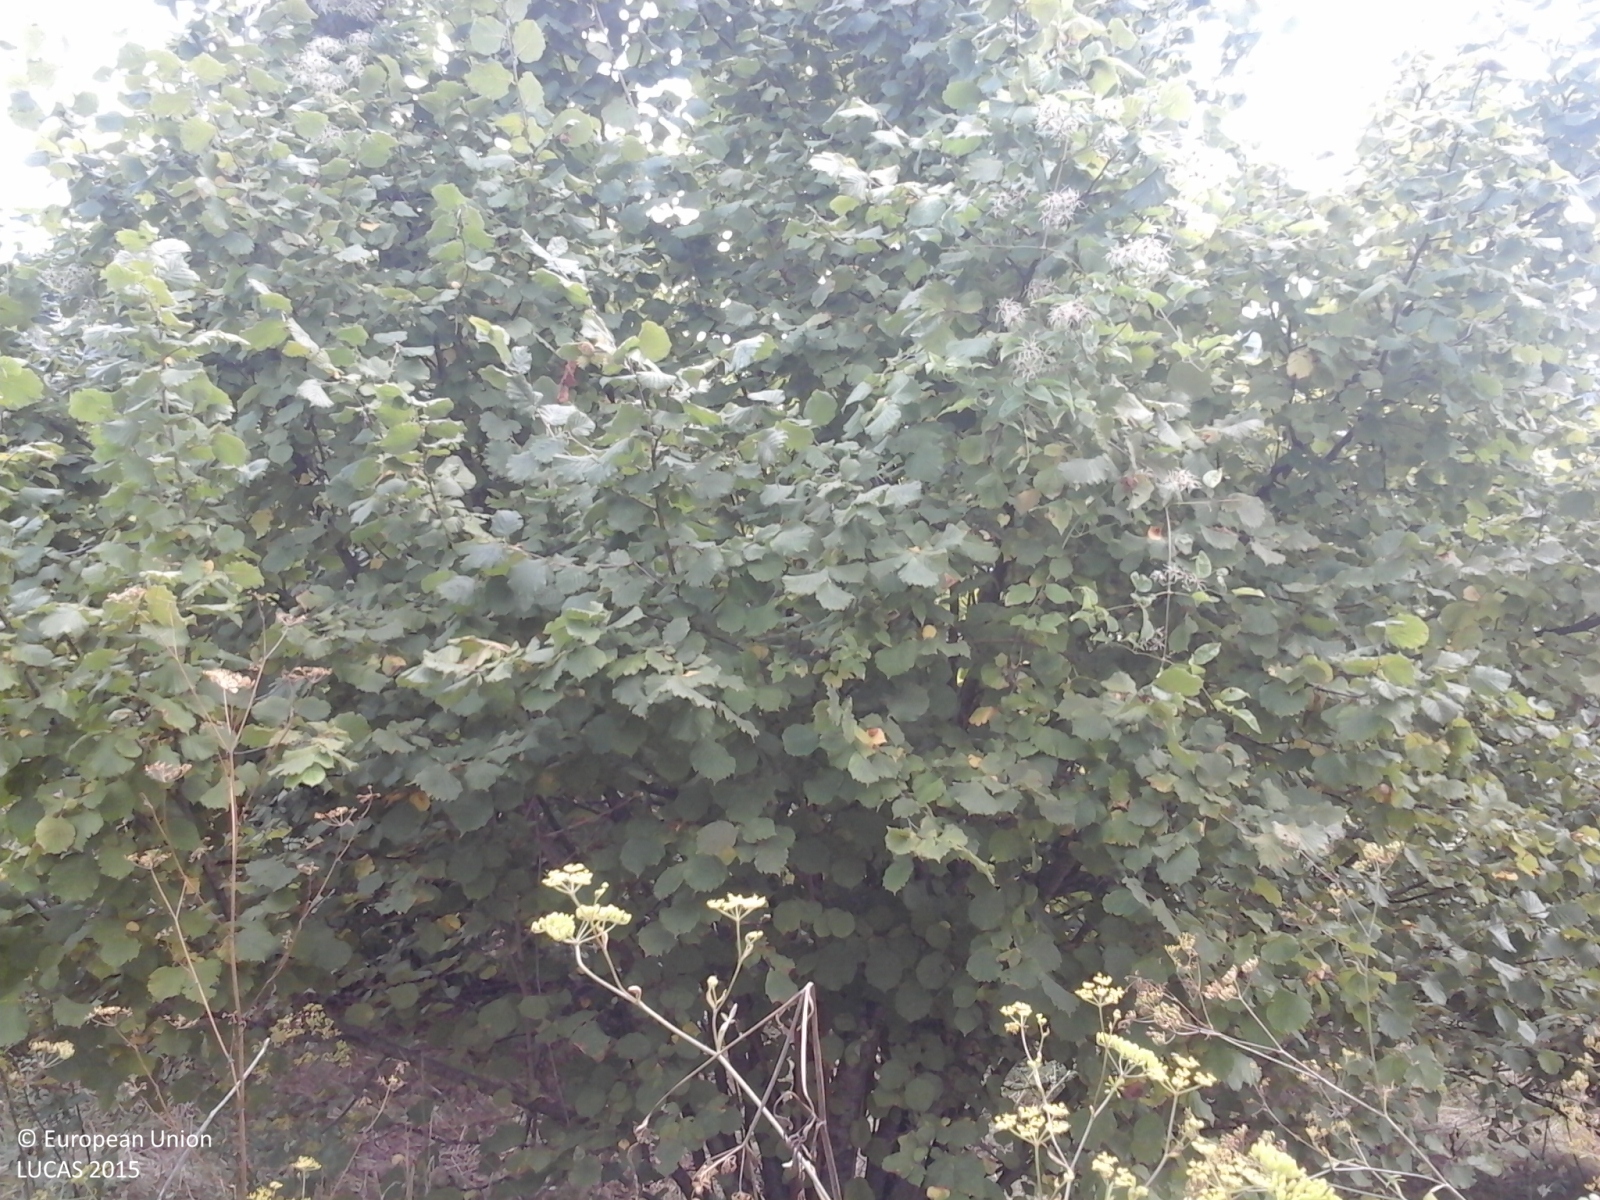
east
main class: Cropland
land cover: Nuts trees
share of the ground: > 75 %
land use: Agriculture (excluding fallow land and kitchen gardens)
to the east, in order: Nuts trees; Fences; Grass margins; Durum wheat; Dry pulses; Spontaneously vegetated surfaces; Artificial constructions in urban areas; Broadleaved woodland; Other fresh vegetables; Grassland with sparse tree/shrub cover; Other fresh vegetables
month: August
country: IT
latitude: 43.3447
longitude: 13.1867
